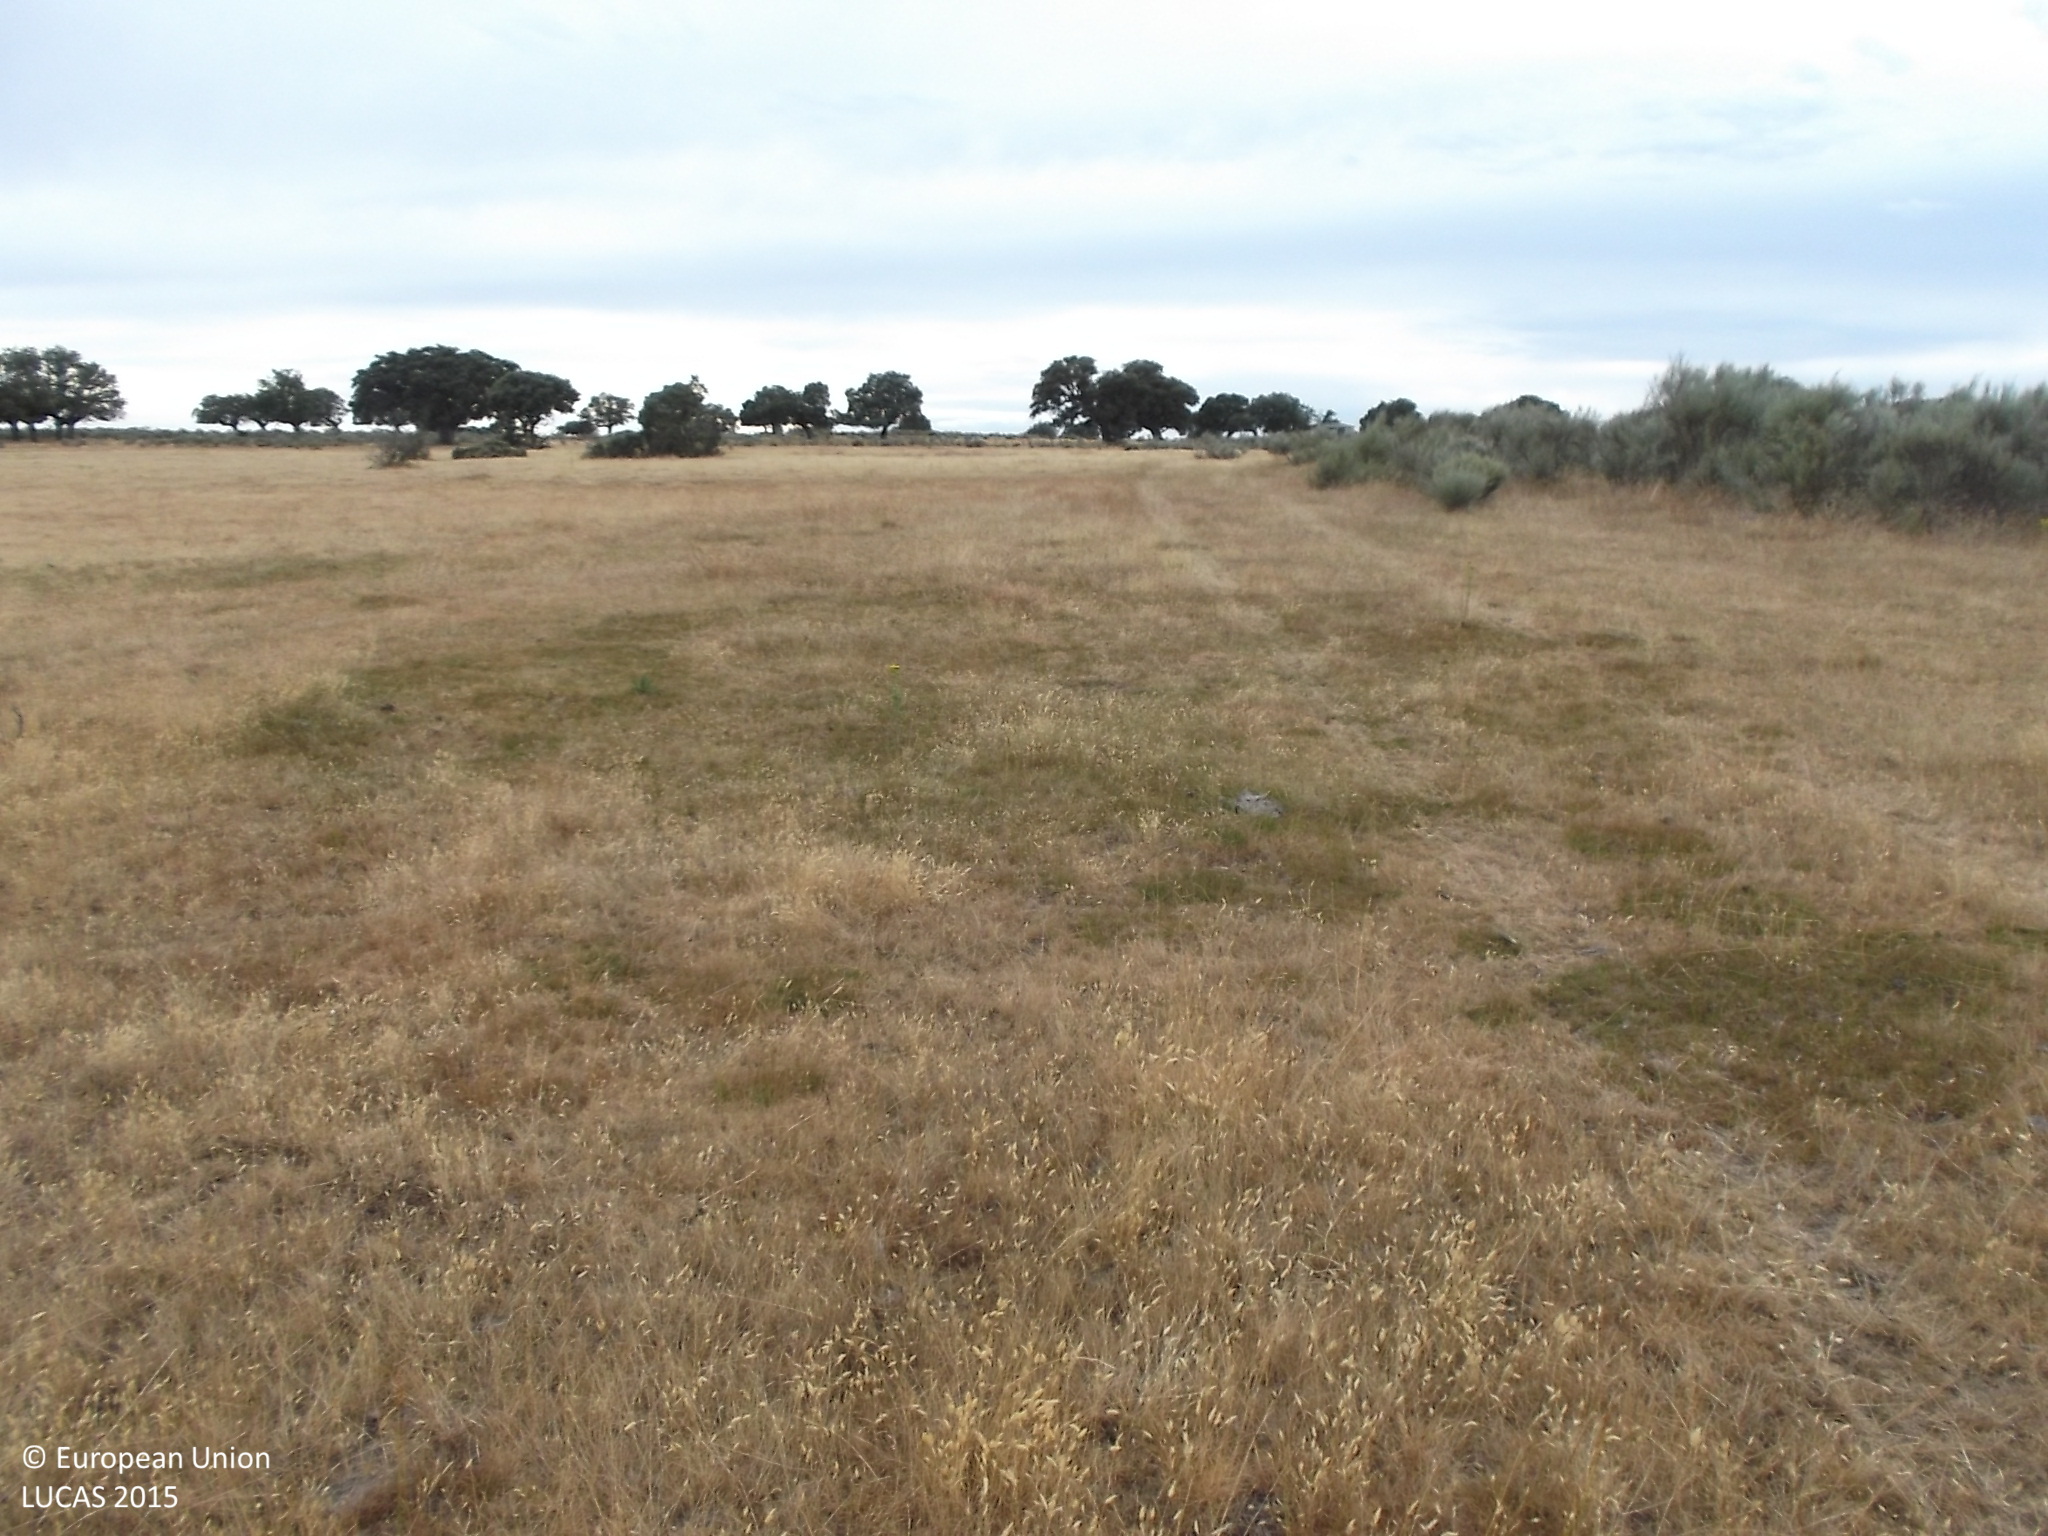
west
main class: Grassland
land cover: Grassland without tree/shrub cover
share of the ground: > 75 %
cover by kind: herbaceous plants 100 %
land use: Agriculture (excluding fallow land and kitchen gardens)
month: July
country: ES
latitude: 41.0619
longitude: -6.4329
